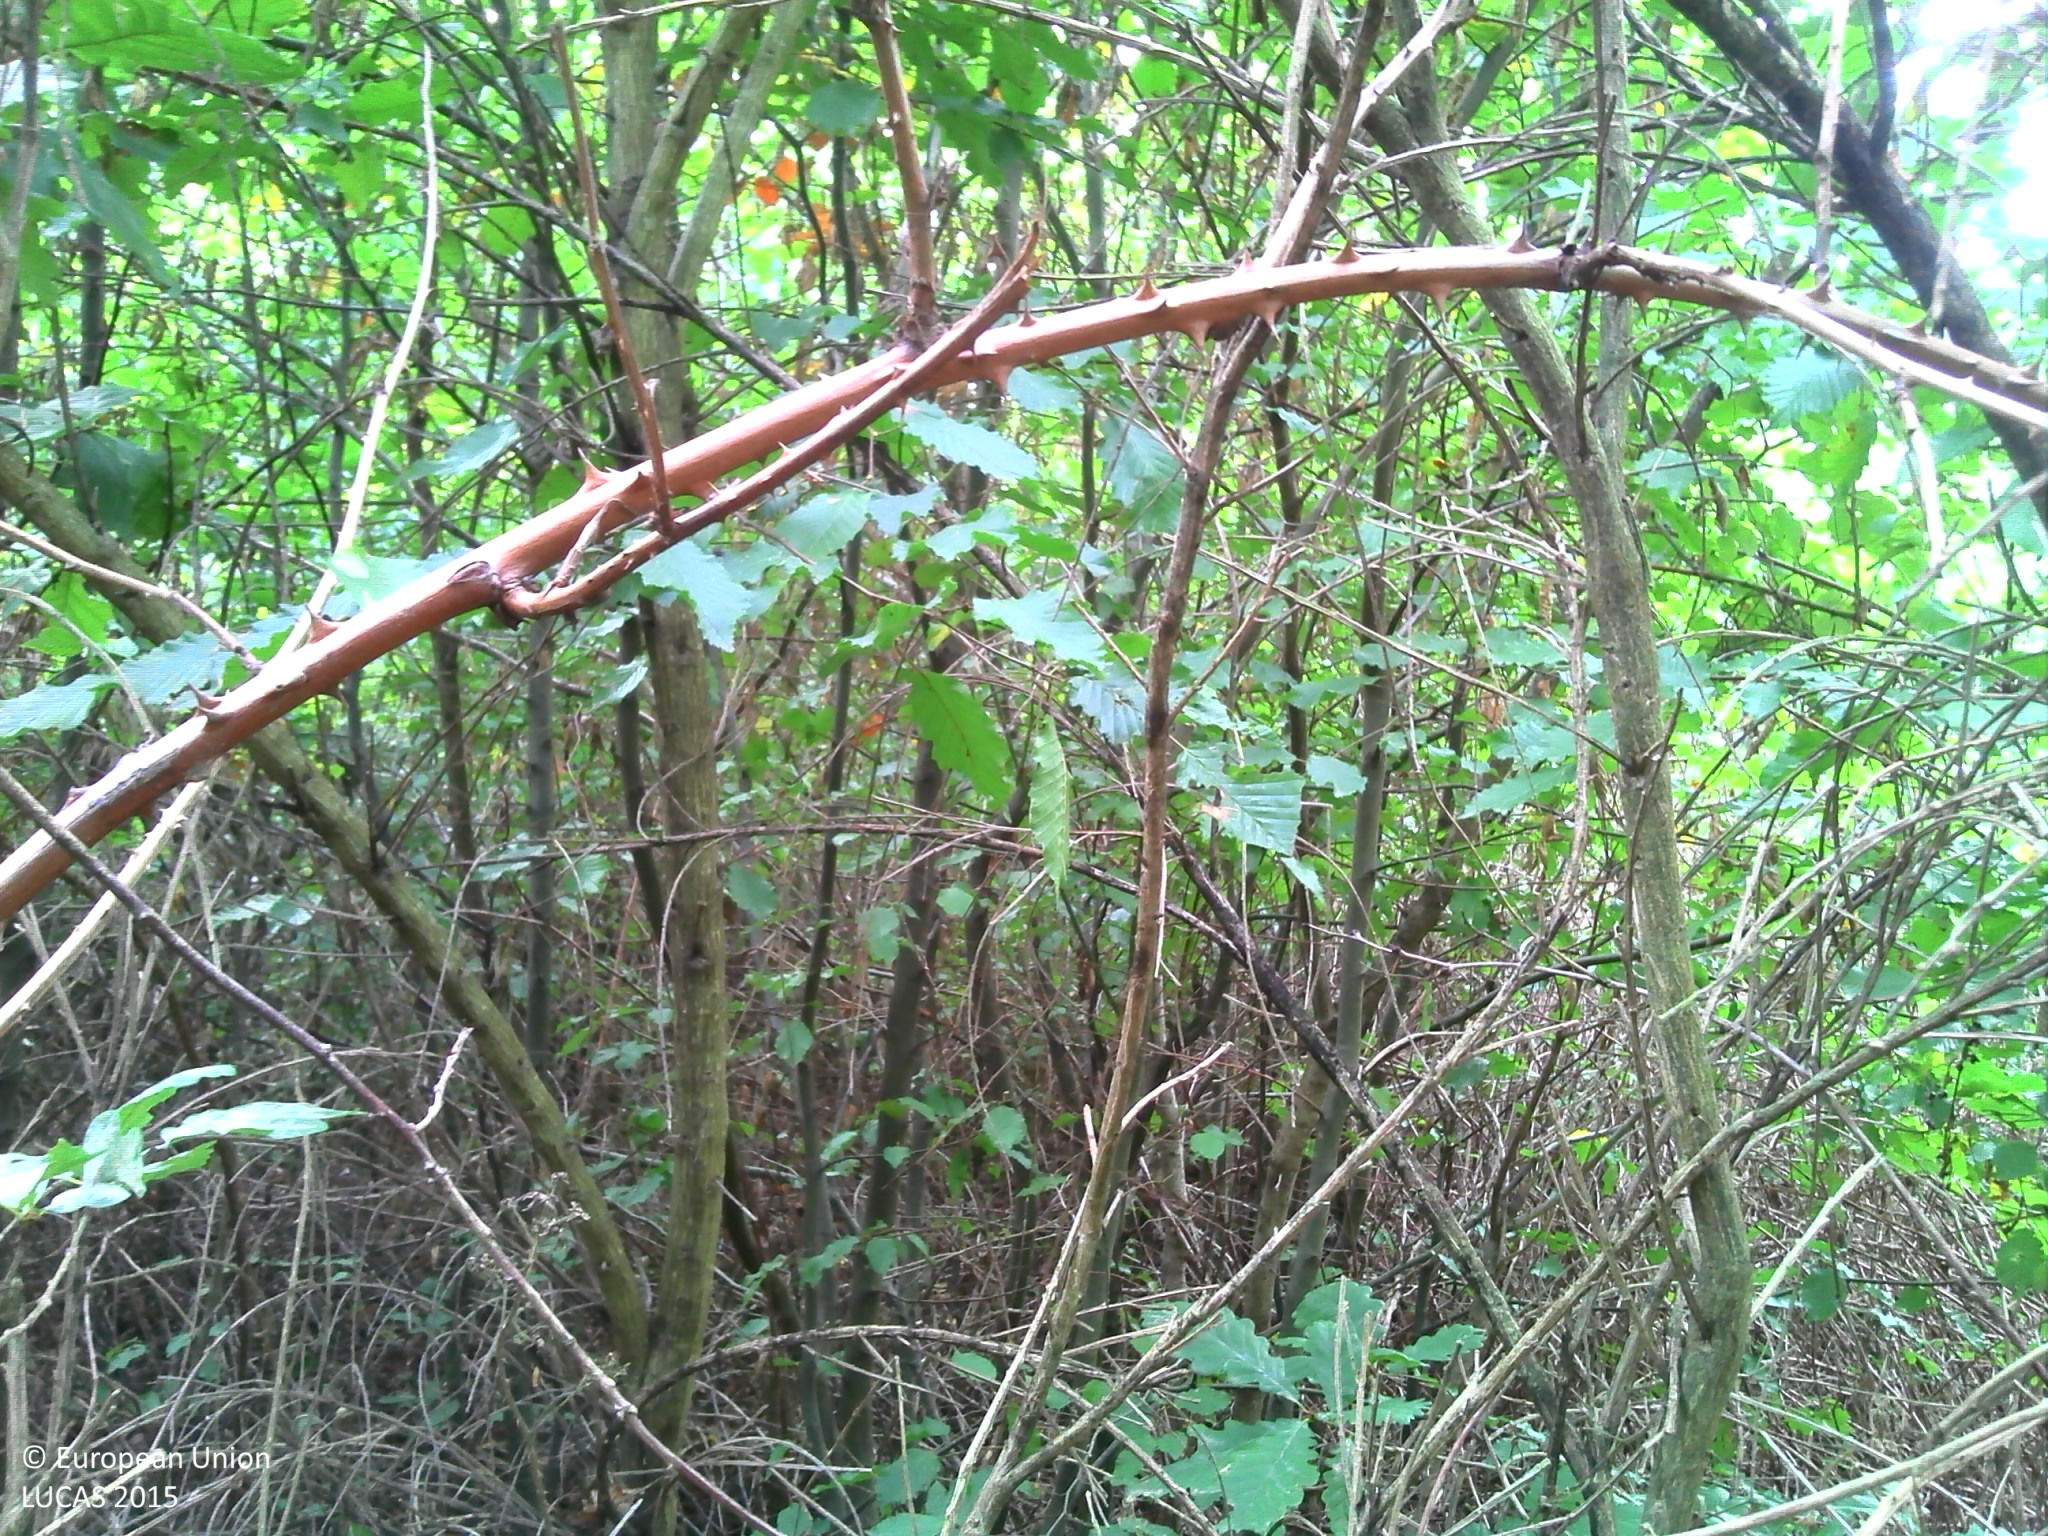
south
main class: Woodland
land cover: Broadleaved woodland
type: mesophytic deciduous forest
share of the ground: > 75 %
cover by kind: broadleaved forest trees 80 %, shrubs 20 %
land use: Forestry
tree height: < 5 m
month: September
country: FR
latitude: 47.1429
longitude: 4.3955
